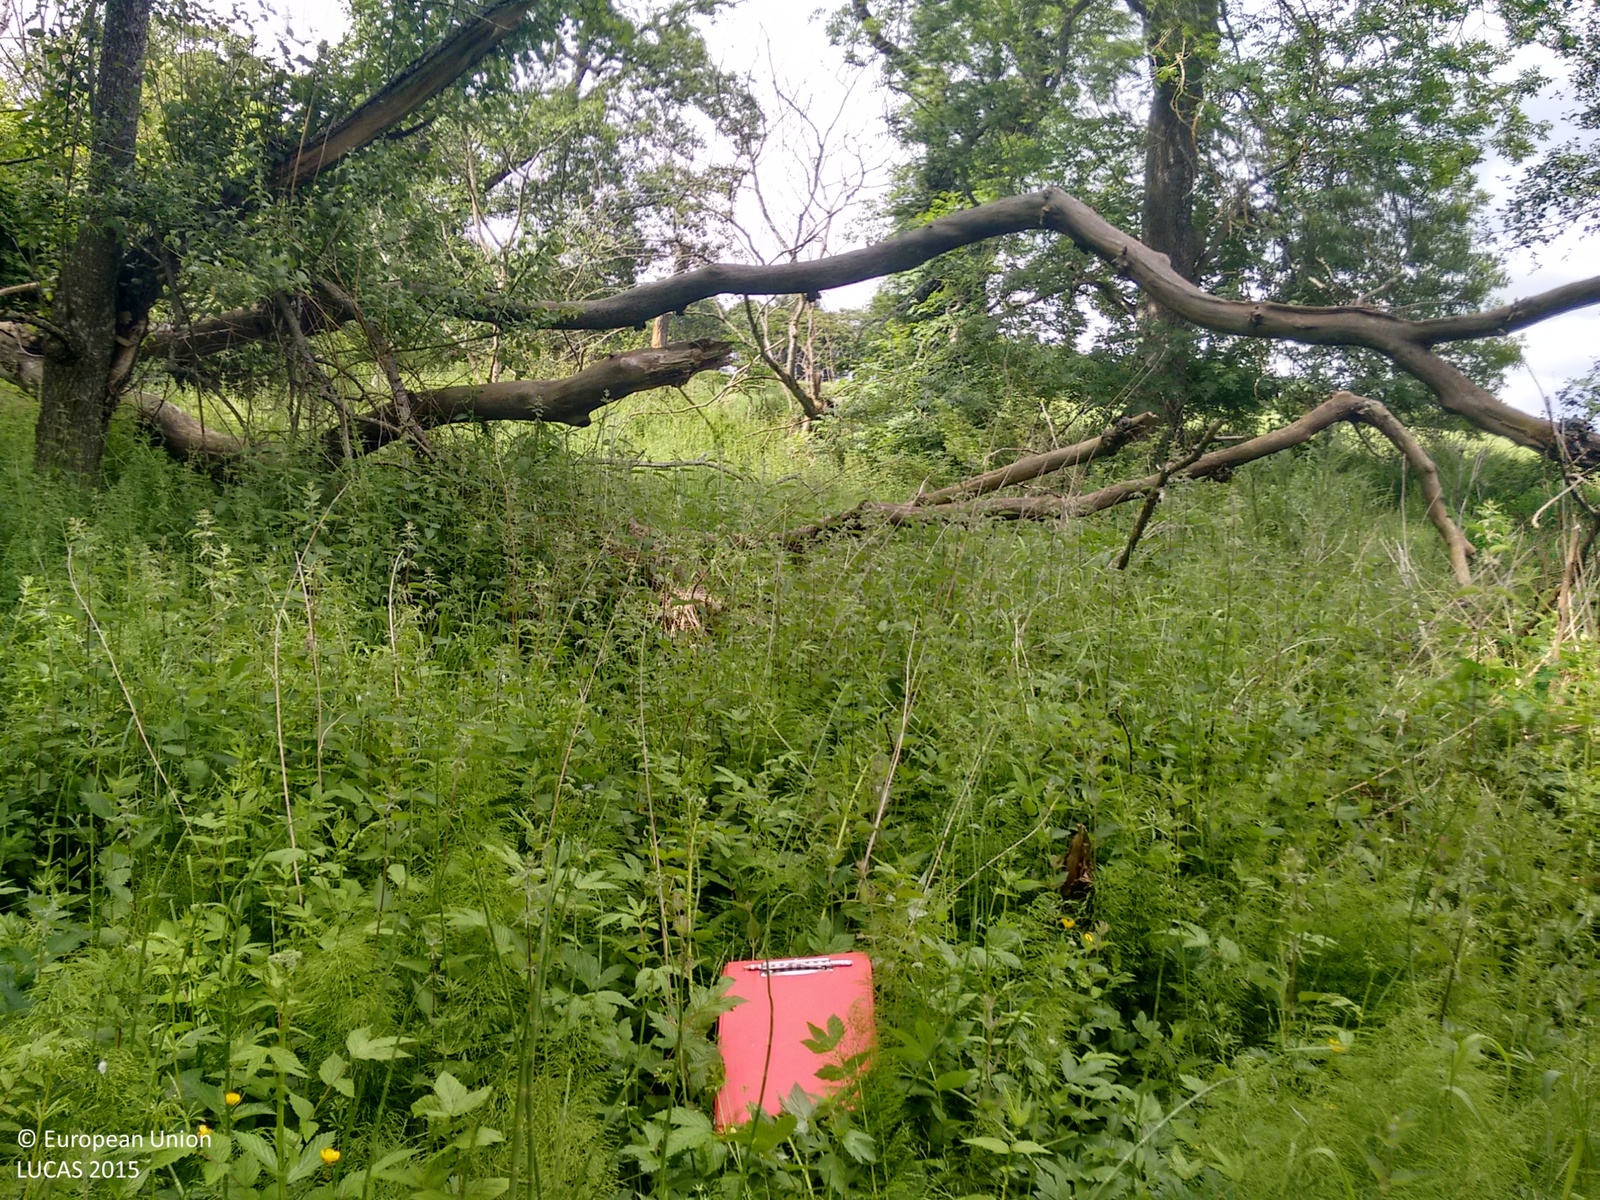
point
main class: Woodland
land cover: Broadleaved woodland
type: exotic forest
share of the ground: > 75 %
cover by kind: broadleaved forest trees 75 %, herbaceous plants 25 %
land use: Semi-natural and natural areas not in use
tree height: > 5 m
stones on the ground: < 10 %
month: June
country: GB
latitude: 57.1750
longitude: -2.7112
